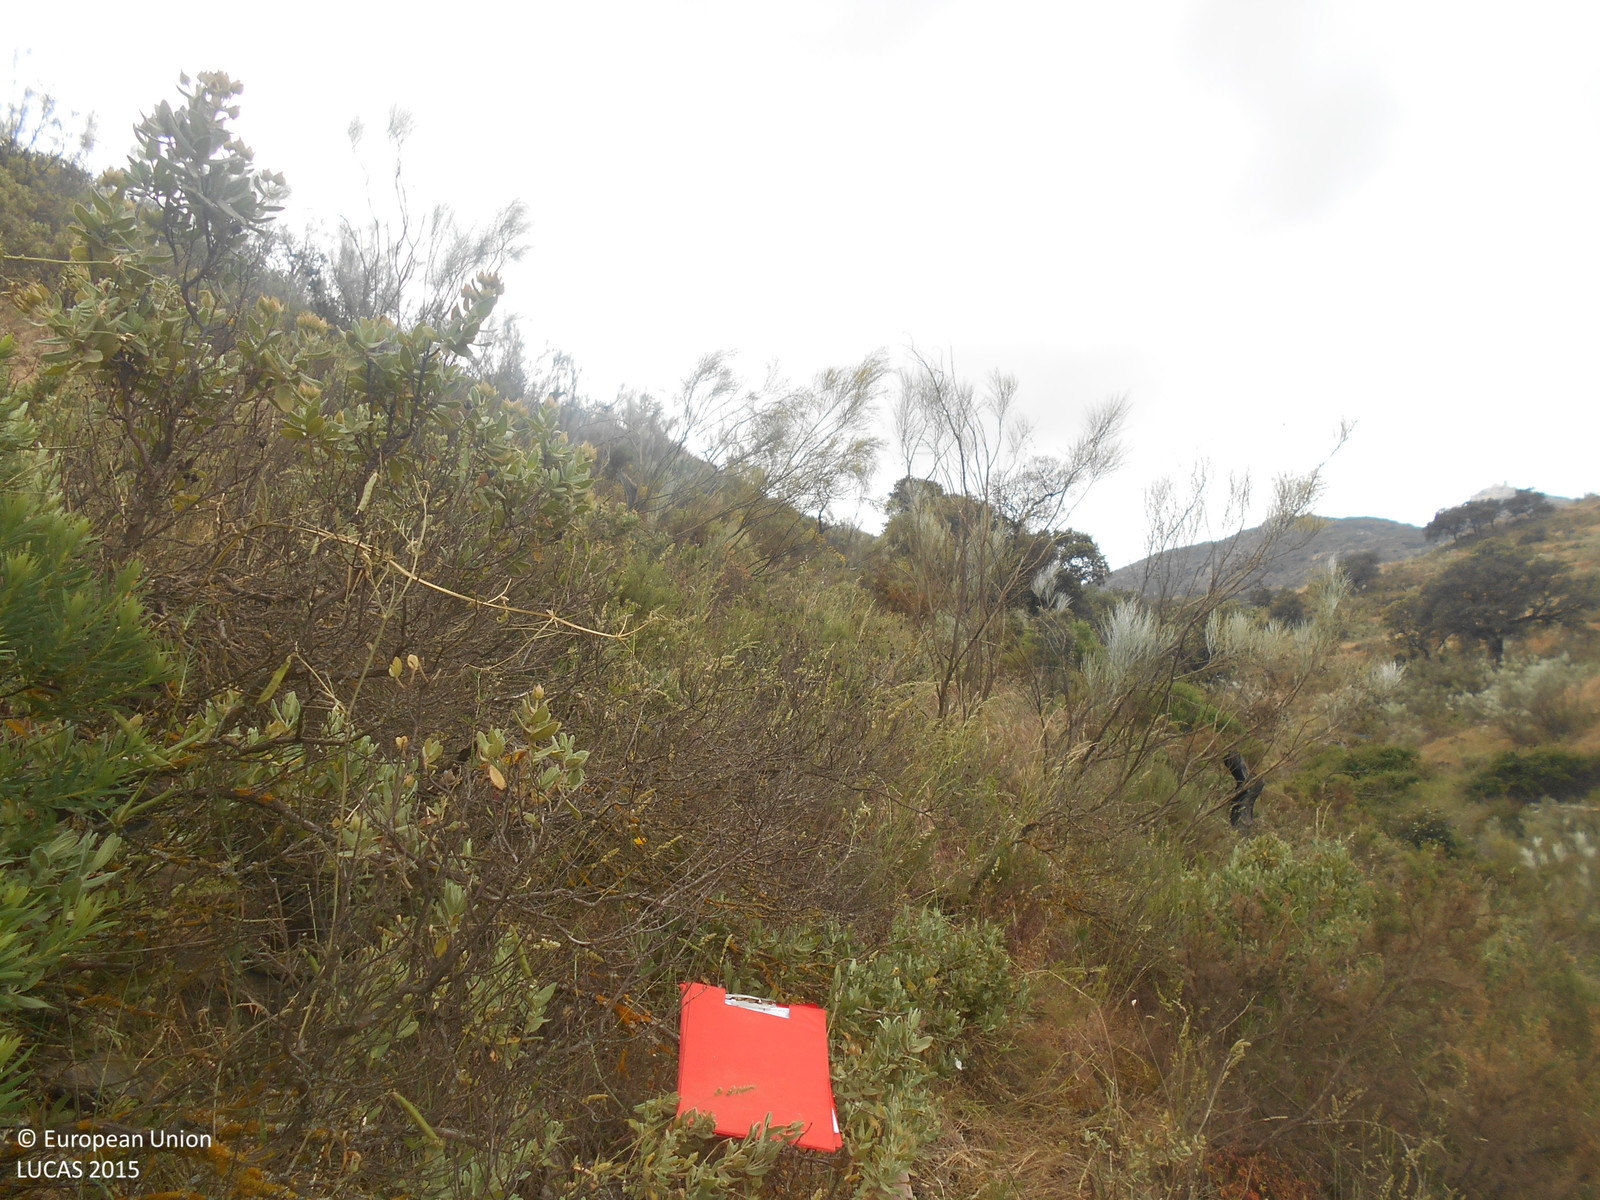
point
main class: Shrubland
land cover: Shrubland with sparse tree cover
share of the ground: > 75 %
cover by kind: shrubs 80 %, herbaceous plants 15 %, broadleaved forest trees 5 %
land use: Semi-natural and natural areas not in use
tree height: < 5 m
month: May
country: ES
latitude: 37.2175
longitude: -2.1836
